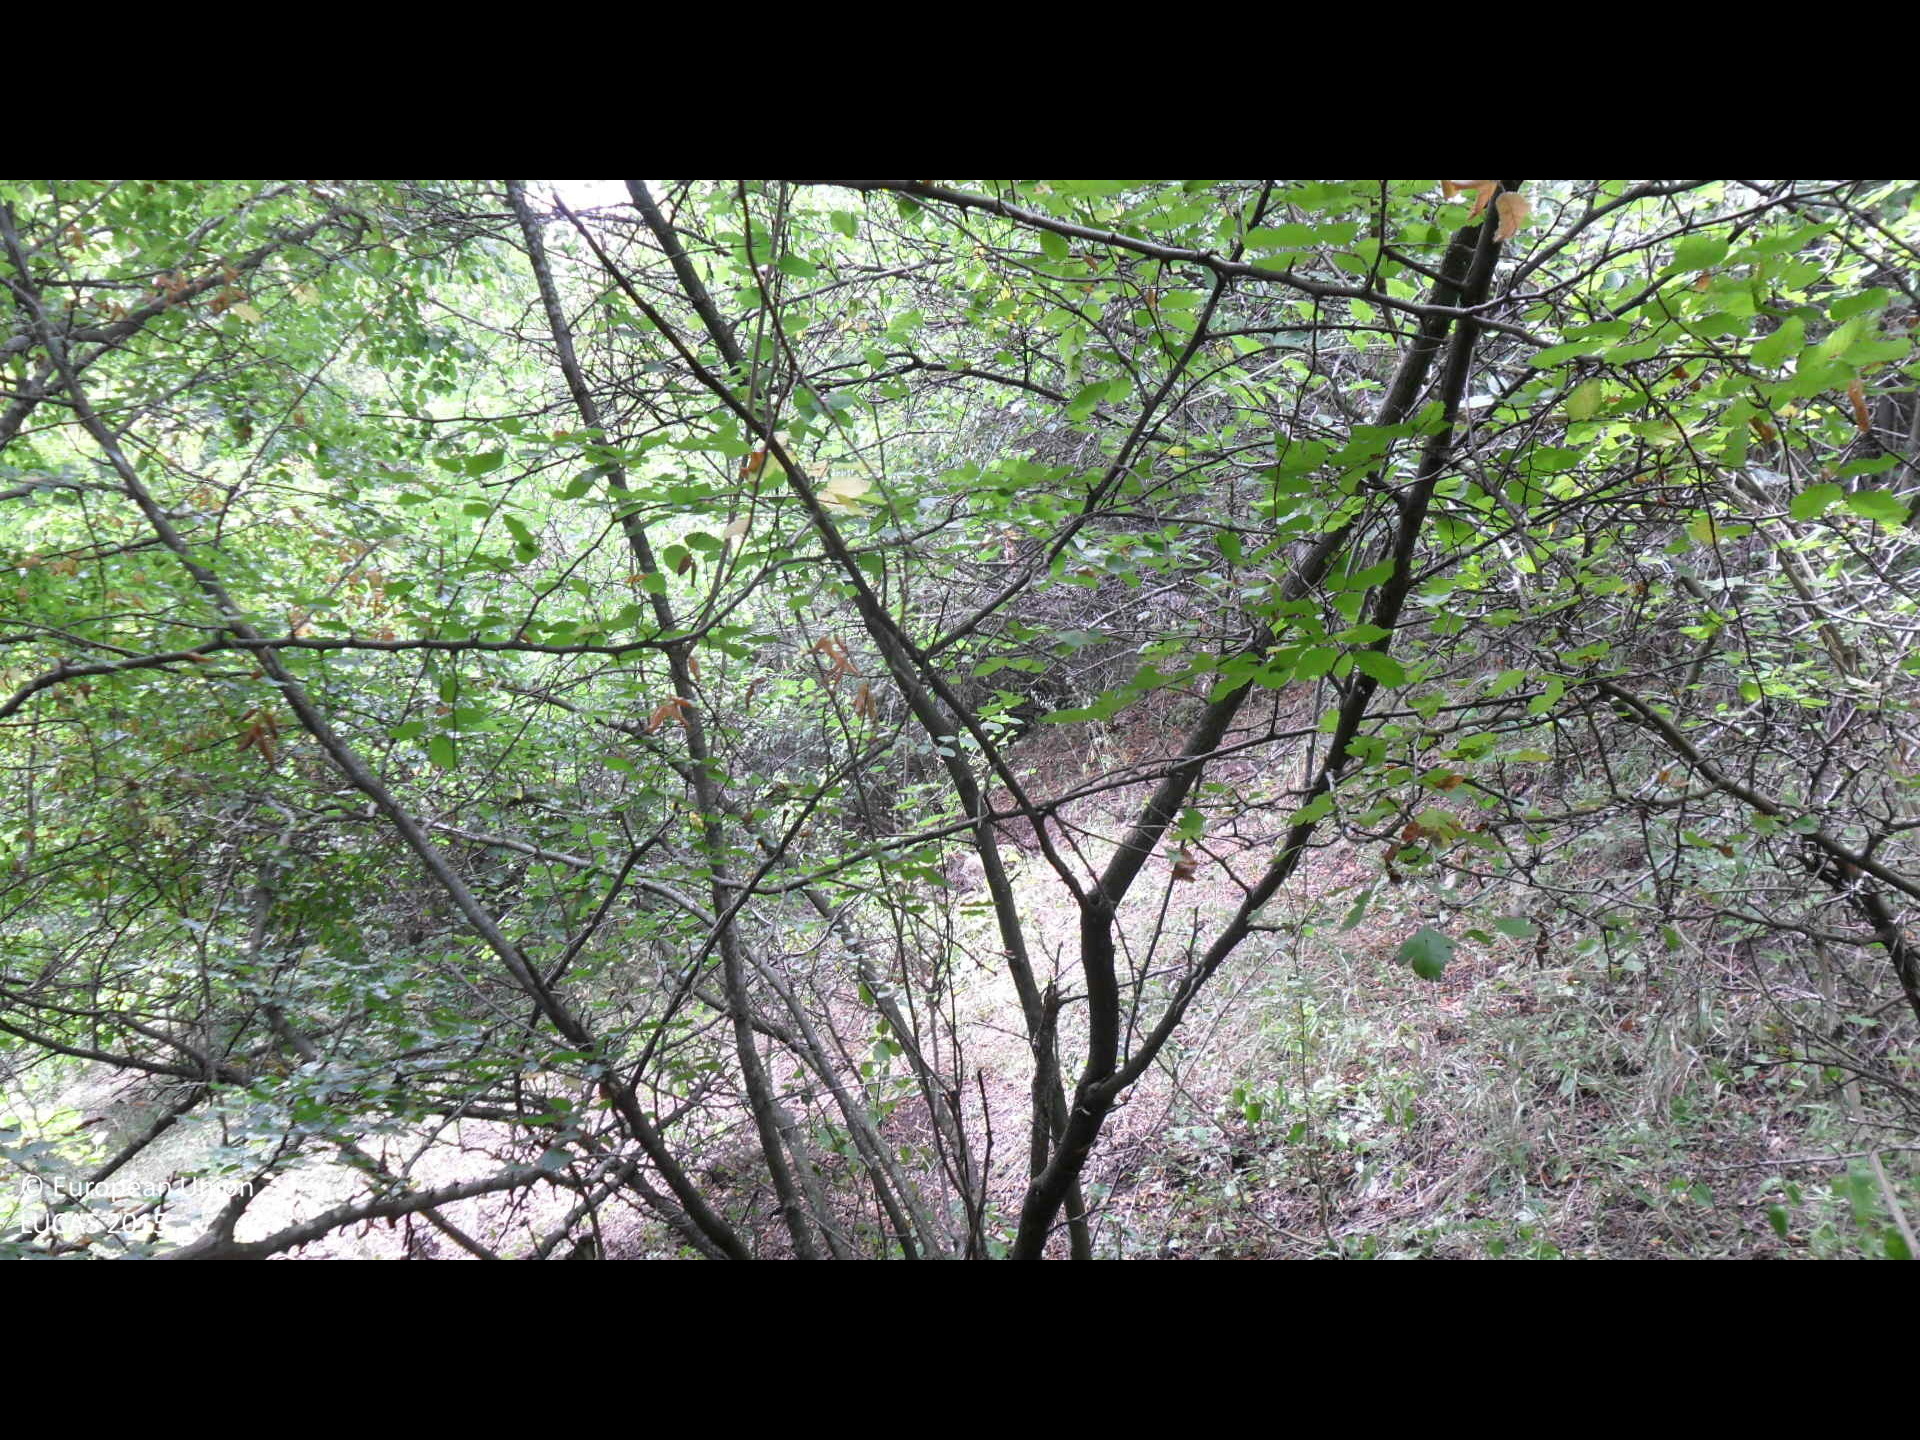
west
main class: Woodland
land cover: Broadleaved woodland
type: mesophytic deciduous forest
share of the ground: 50 - 75 %
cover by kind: broadleaved forest trees 100 %
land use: Forestry
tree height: > 5 m
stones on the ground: 10 - 25 %
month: August
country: BG
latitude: 43.5137
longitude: 26.1657
